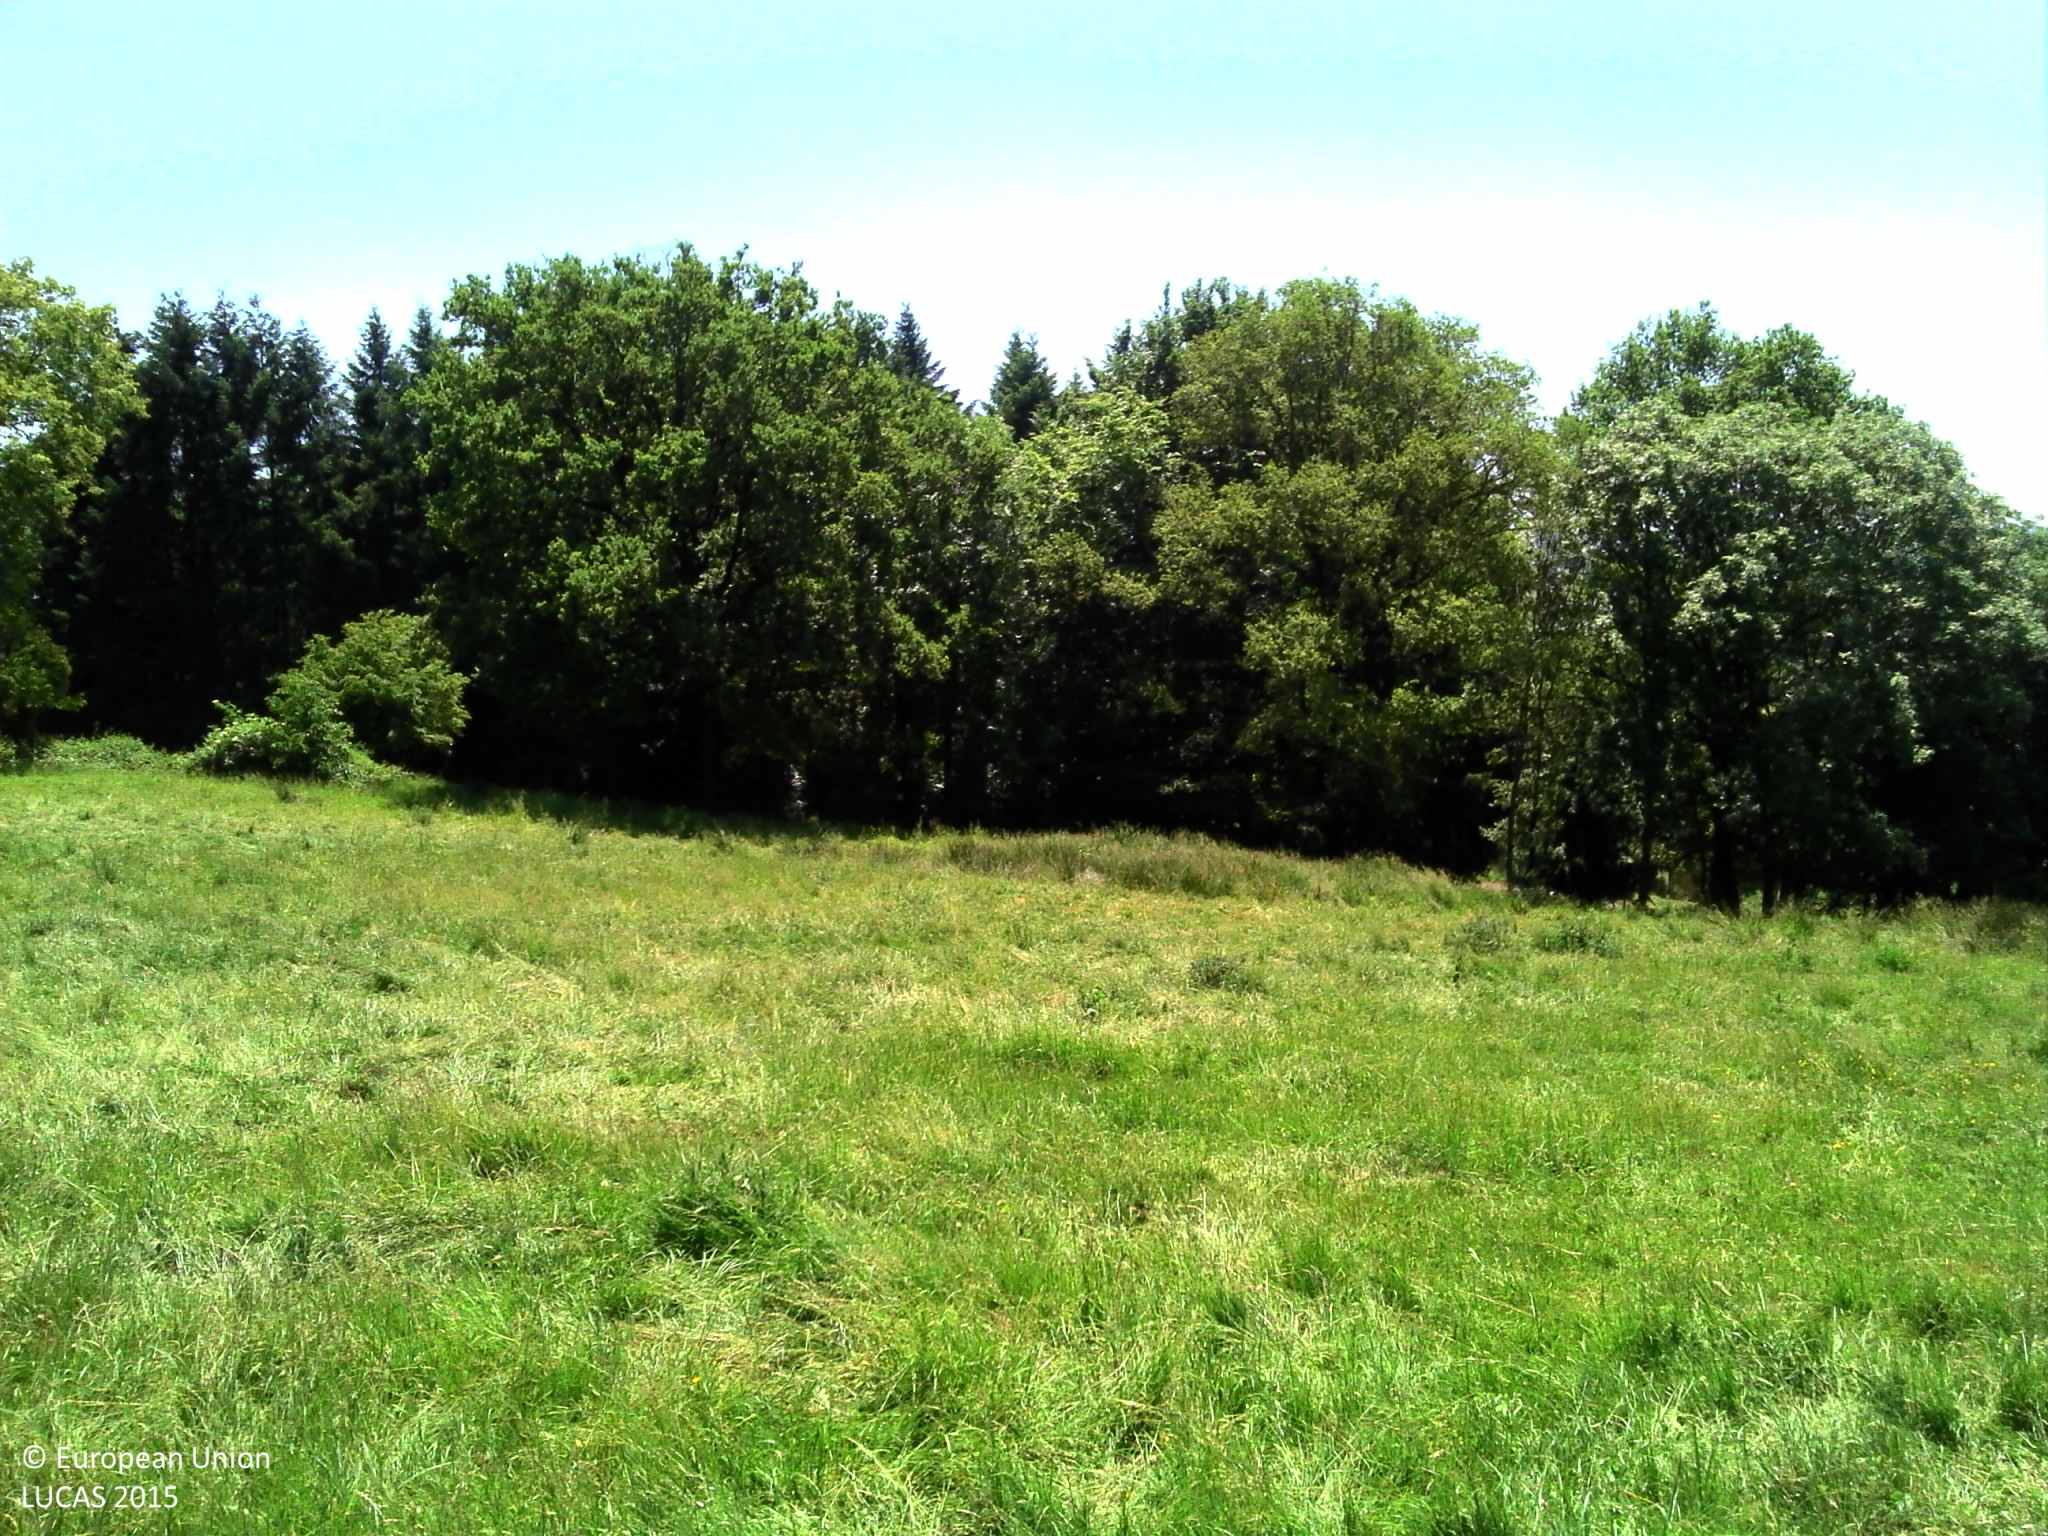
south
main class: Grassland
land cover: Grassland without tree/shrub cover
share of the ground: > 75 %
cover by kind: herbaceous plants 100 %
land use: Agriculture (excluding fallow land and kitchen gardens)
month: June
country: FR
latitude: 45.3590
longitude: 2.4286
